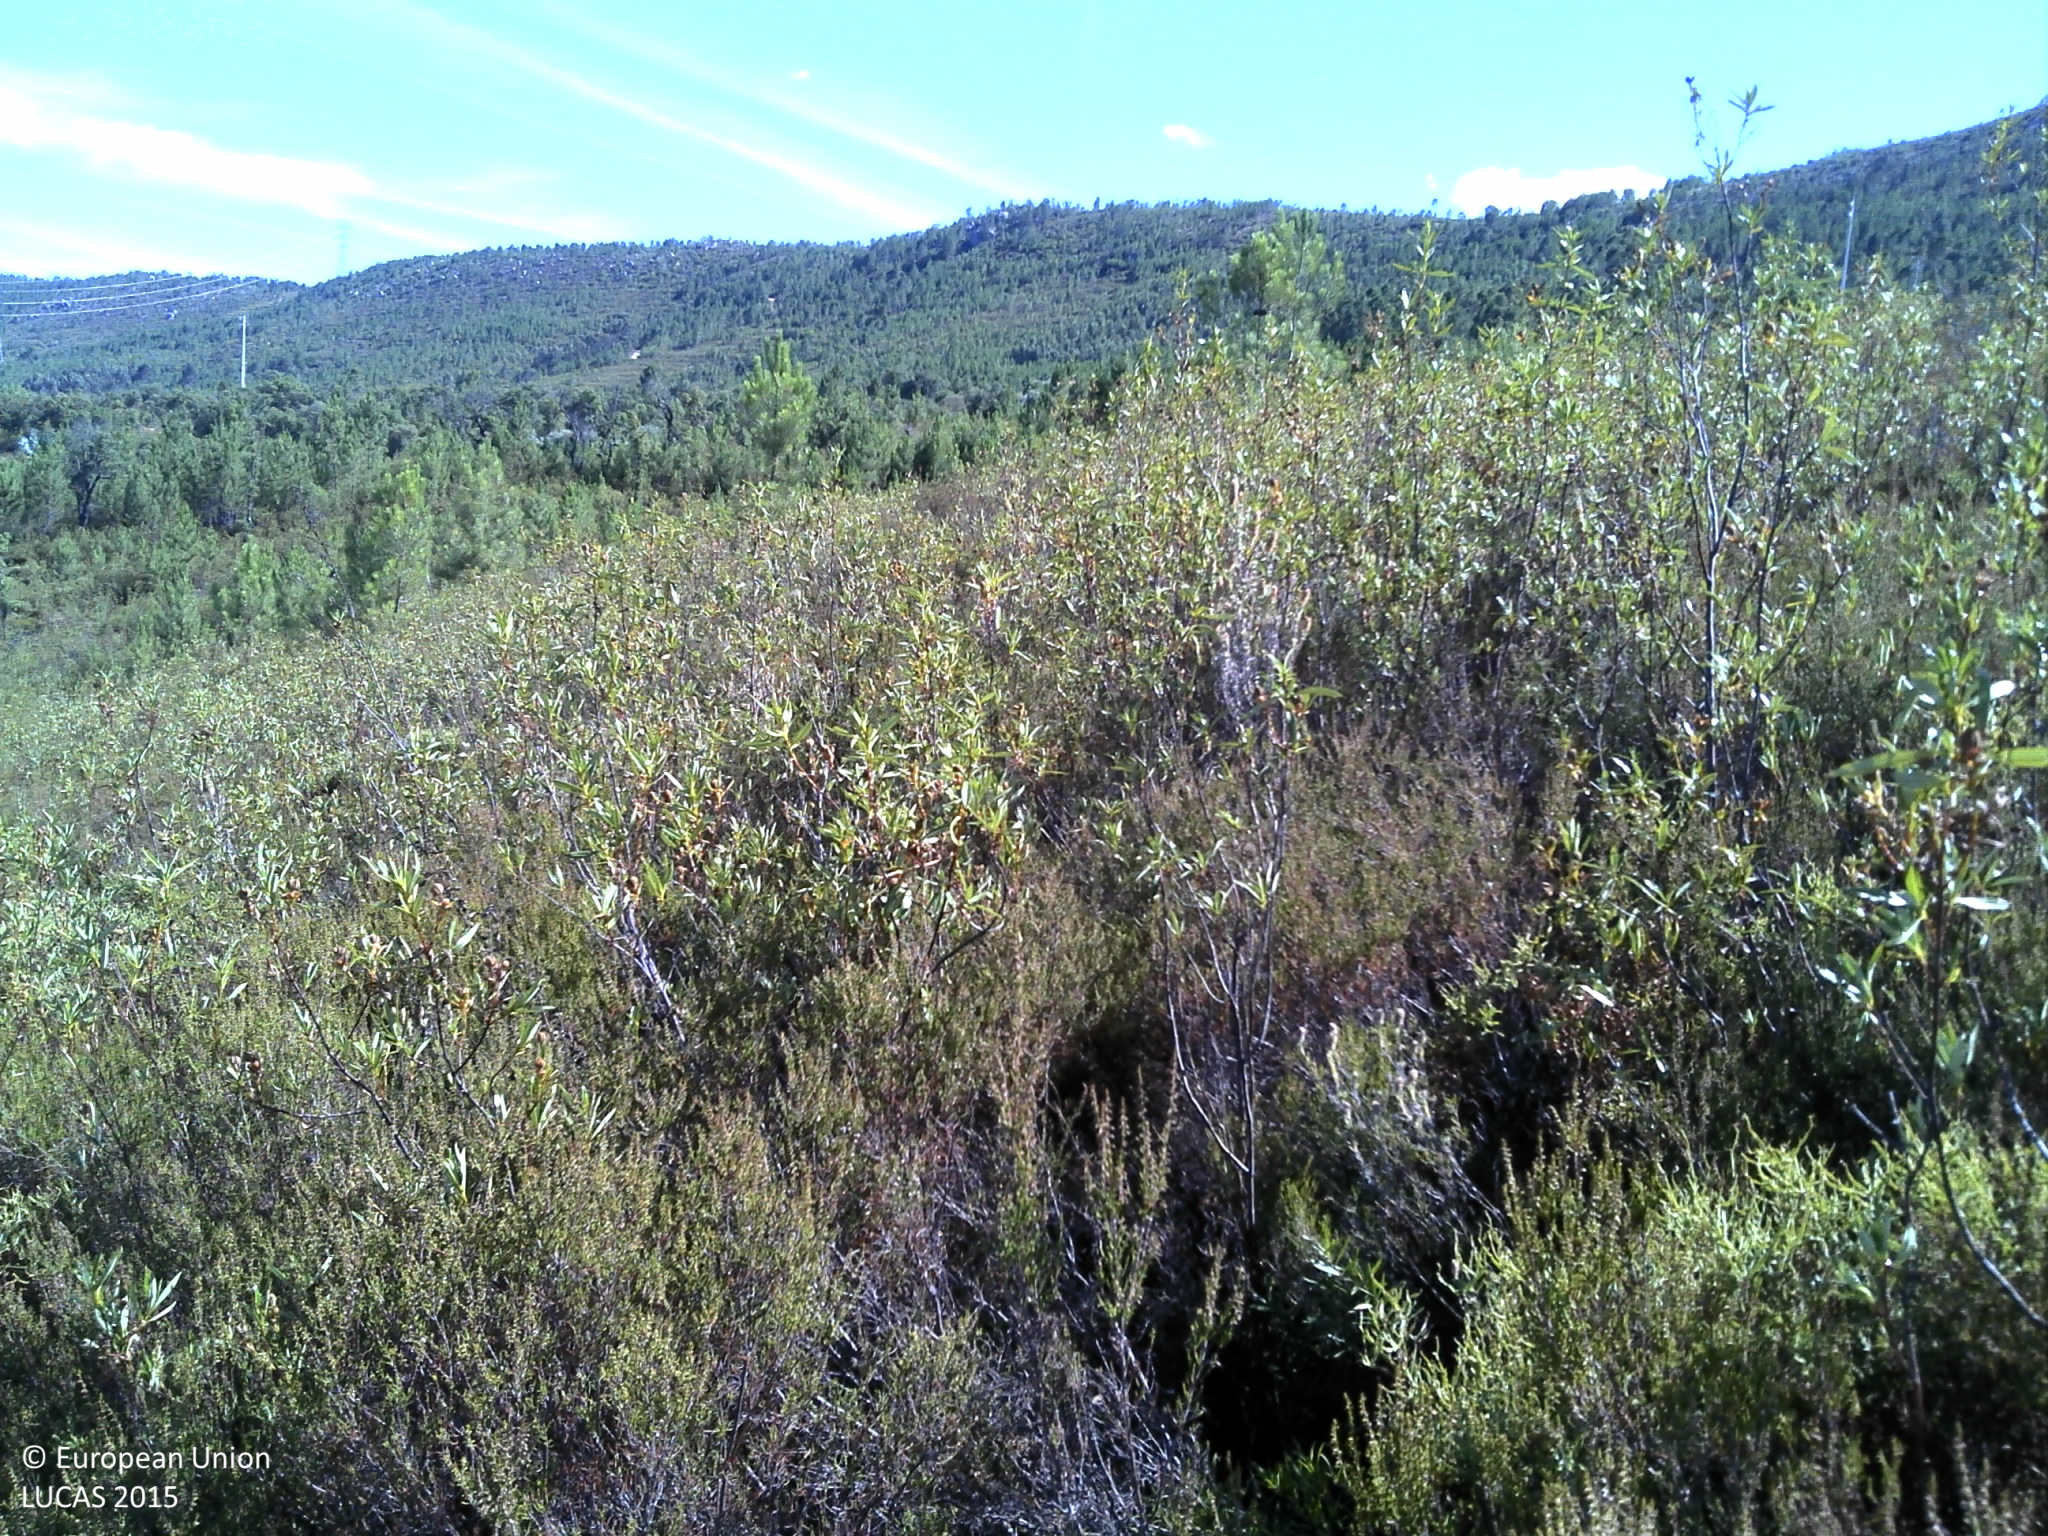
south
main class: Shrubland
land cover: Shrubland without tree cover
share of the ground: > 75 %
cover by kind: shrubs 100 %
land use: Semi-natural and natural areas not in use
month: July
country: PT
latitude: 39.7272
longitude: -7.7320
